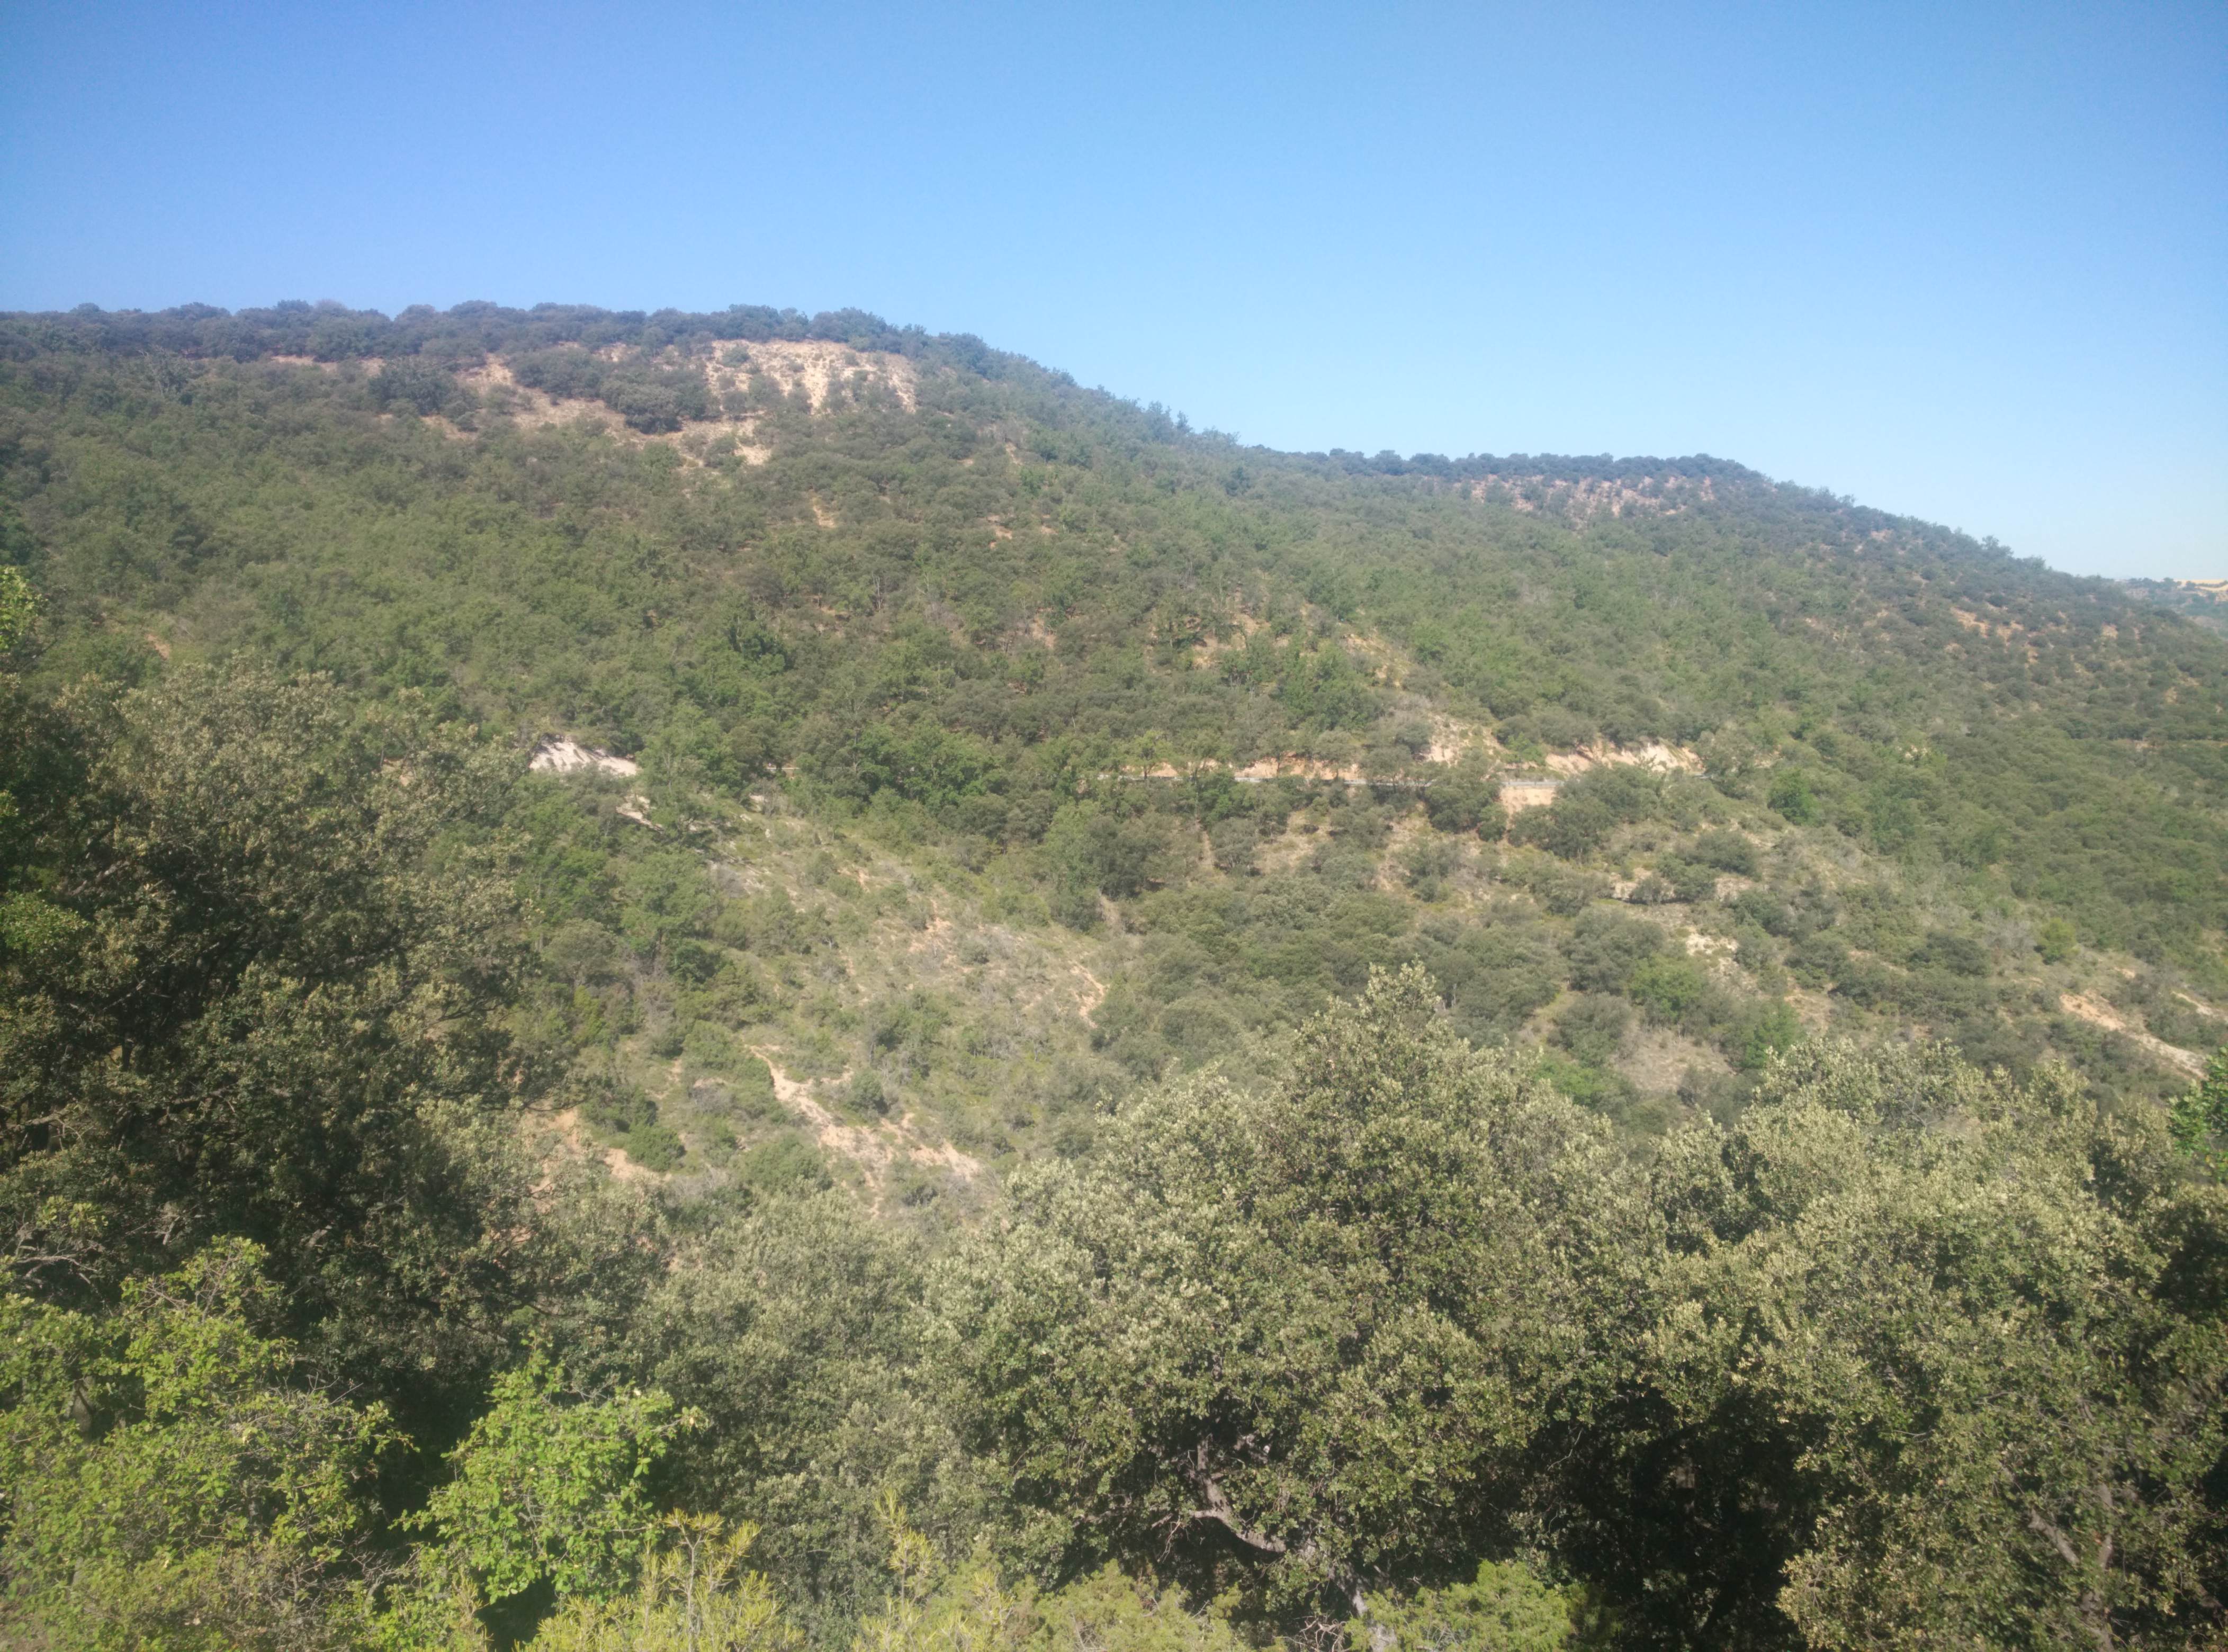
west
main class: Woodland
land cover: Broadleaved woodland
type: thermophilous deciduous forest
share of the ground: 50 - 75 %
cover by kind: broadleaved forest trees 60 %, unconsolidated bare surface 30 %, shrubs 10 %
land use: Semi-natural and natural areas not in use
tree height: > 5 m
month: July
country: ES
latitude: 40.7169
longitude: -2.8512
